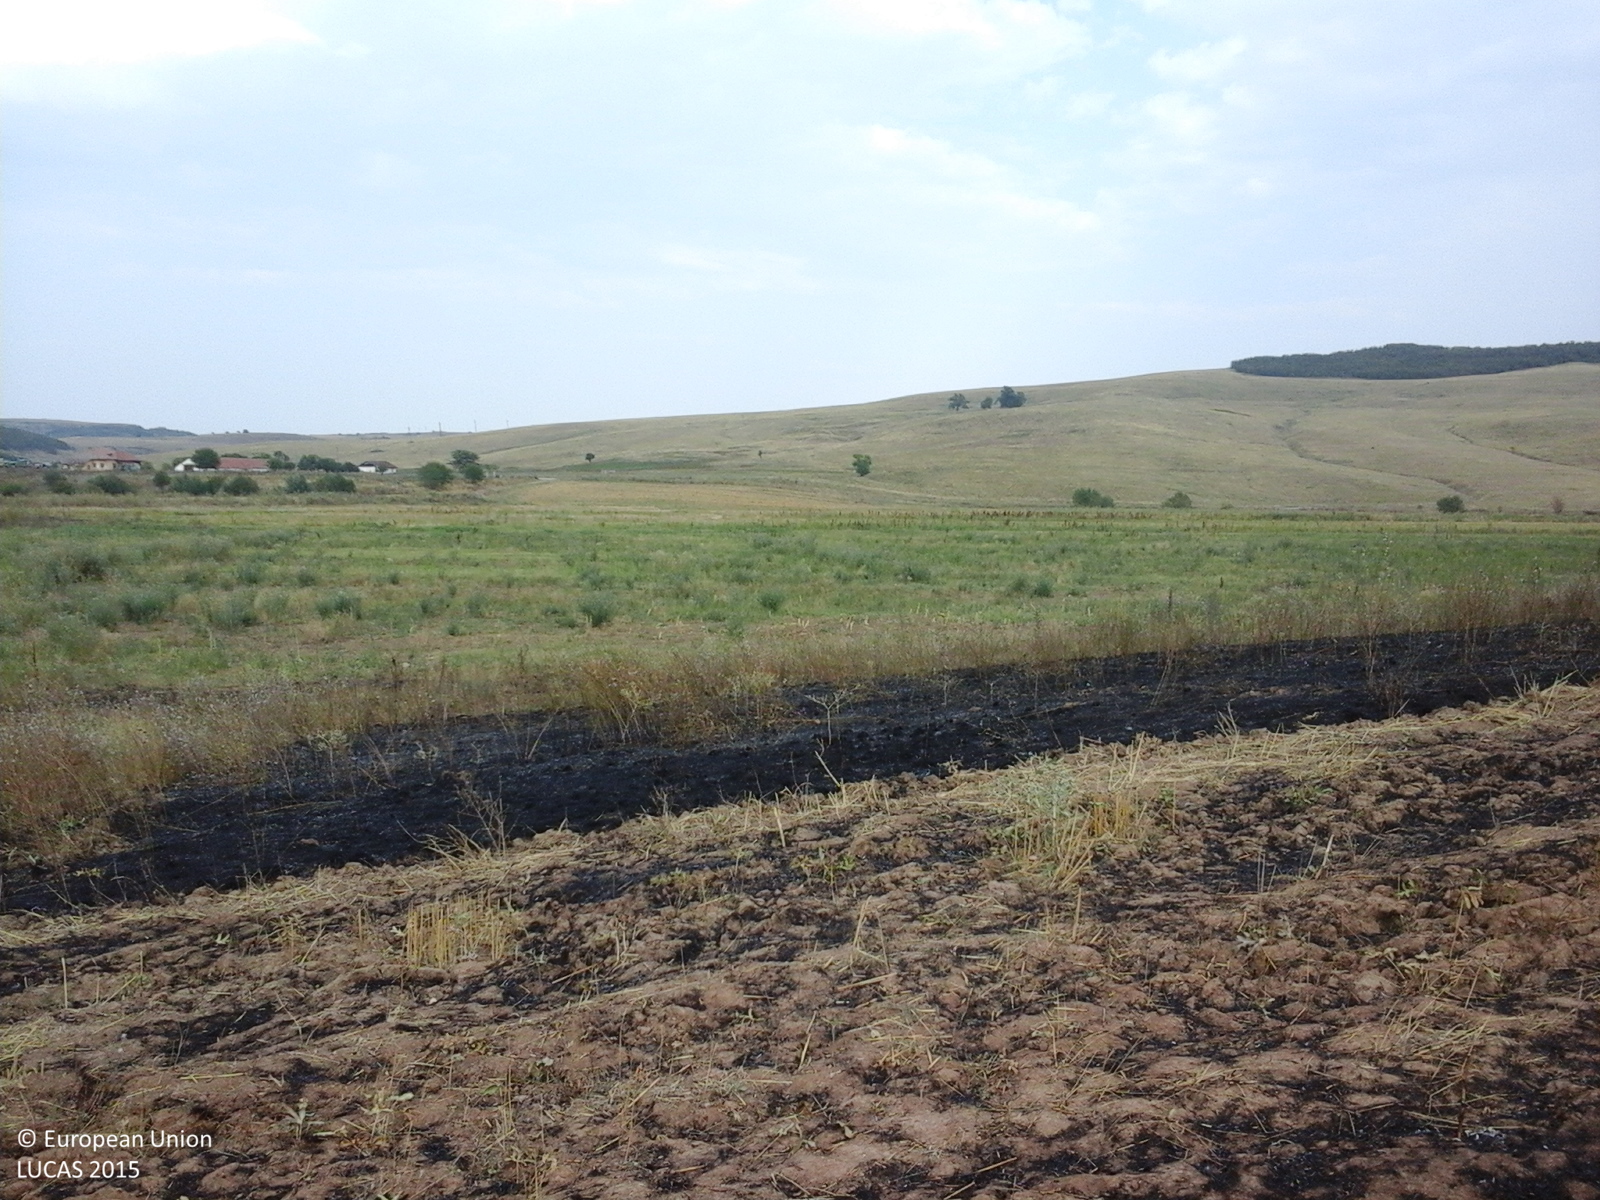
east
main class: Cropland
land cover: Durum wheat
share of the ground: 10 - 25 %
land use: Agriculture (excluding fallow land and kitchen gardens)
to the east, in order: Durum wheat; Spontaneously vegetated surfaces; Tracks; Grassland without tree/shrub cover; Ditches and canals; Grassland without tree/shrub cover; Tracks; Grassland without tree/shrub cover; Ditches and canals; Grassland without tree/shrub cover
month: August
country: RO
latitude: 44.4529
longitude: 23.0526
